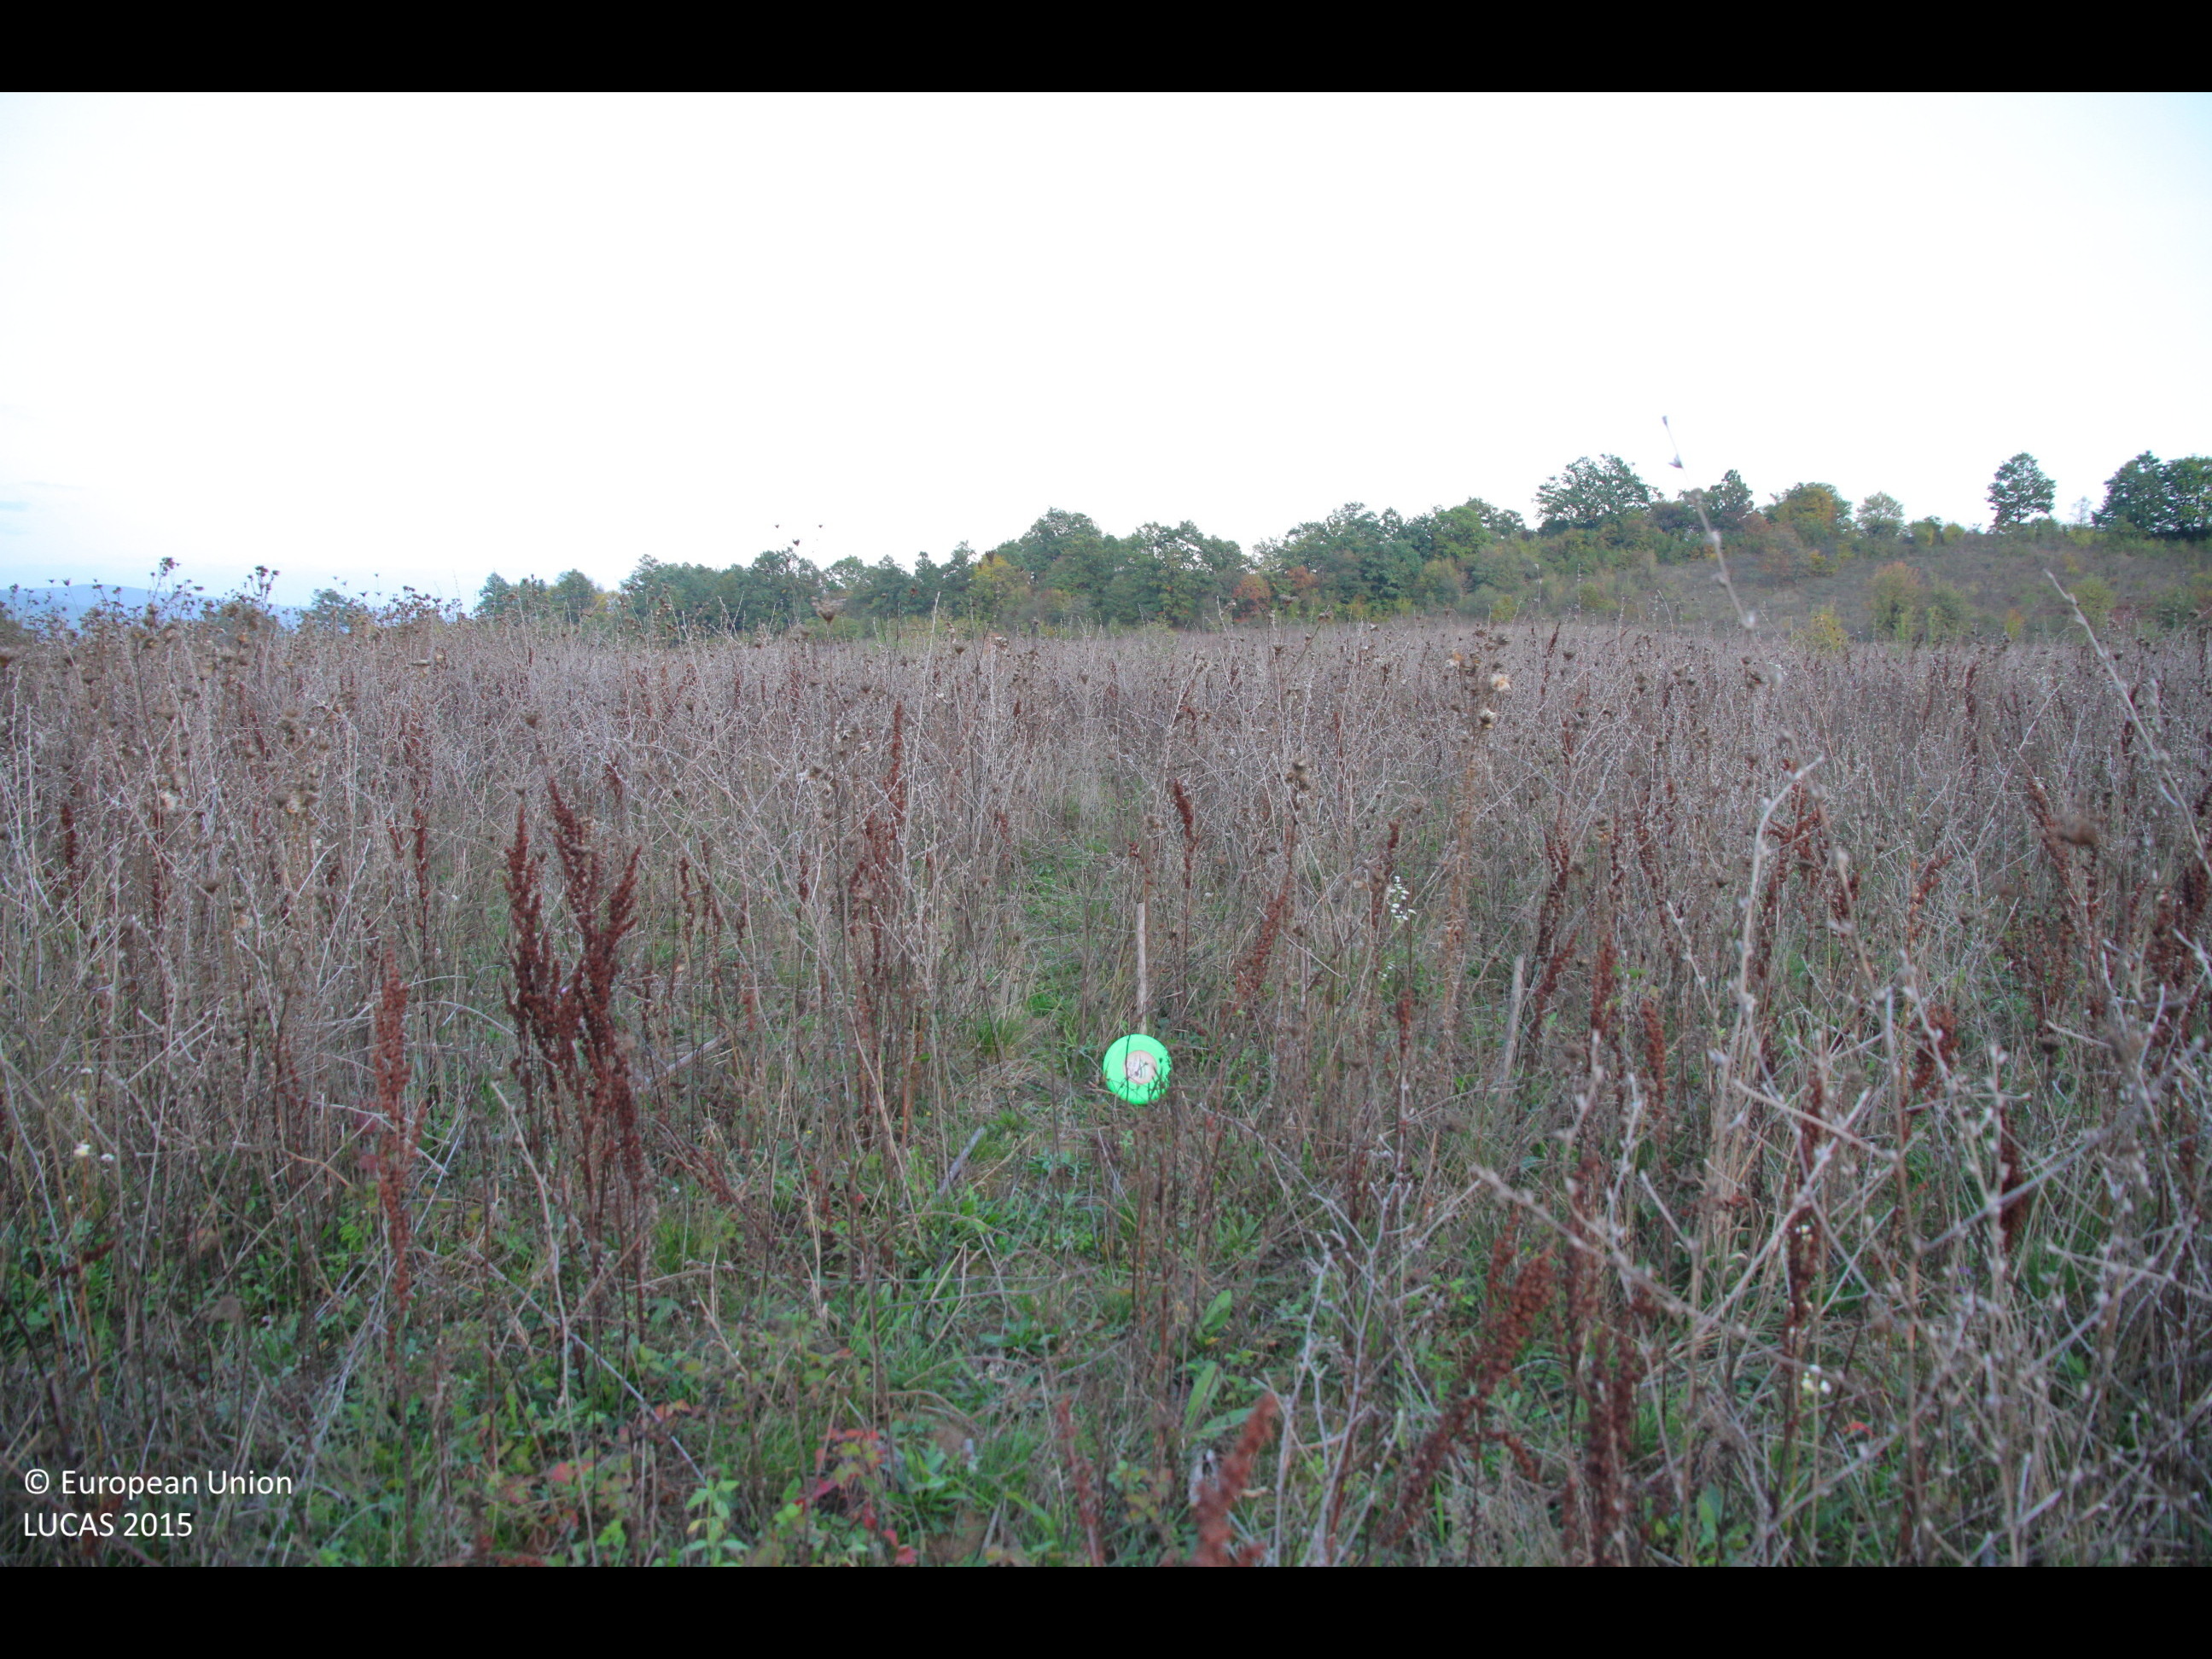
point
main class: Grassland
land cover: Spontaneously vegetated surfaces
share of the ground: > 75 %
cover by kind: herbaceous plants 100 %
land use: Agriculture (excluding fallow land and kitchen gardens)
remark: Harvested field
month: October
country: BG
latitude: 42.9729
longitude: 26.9946
